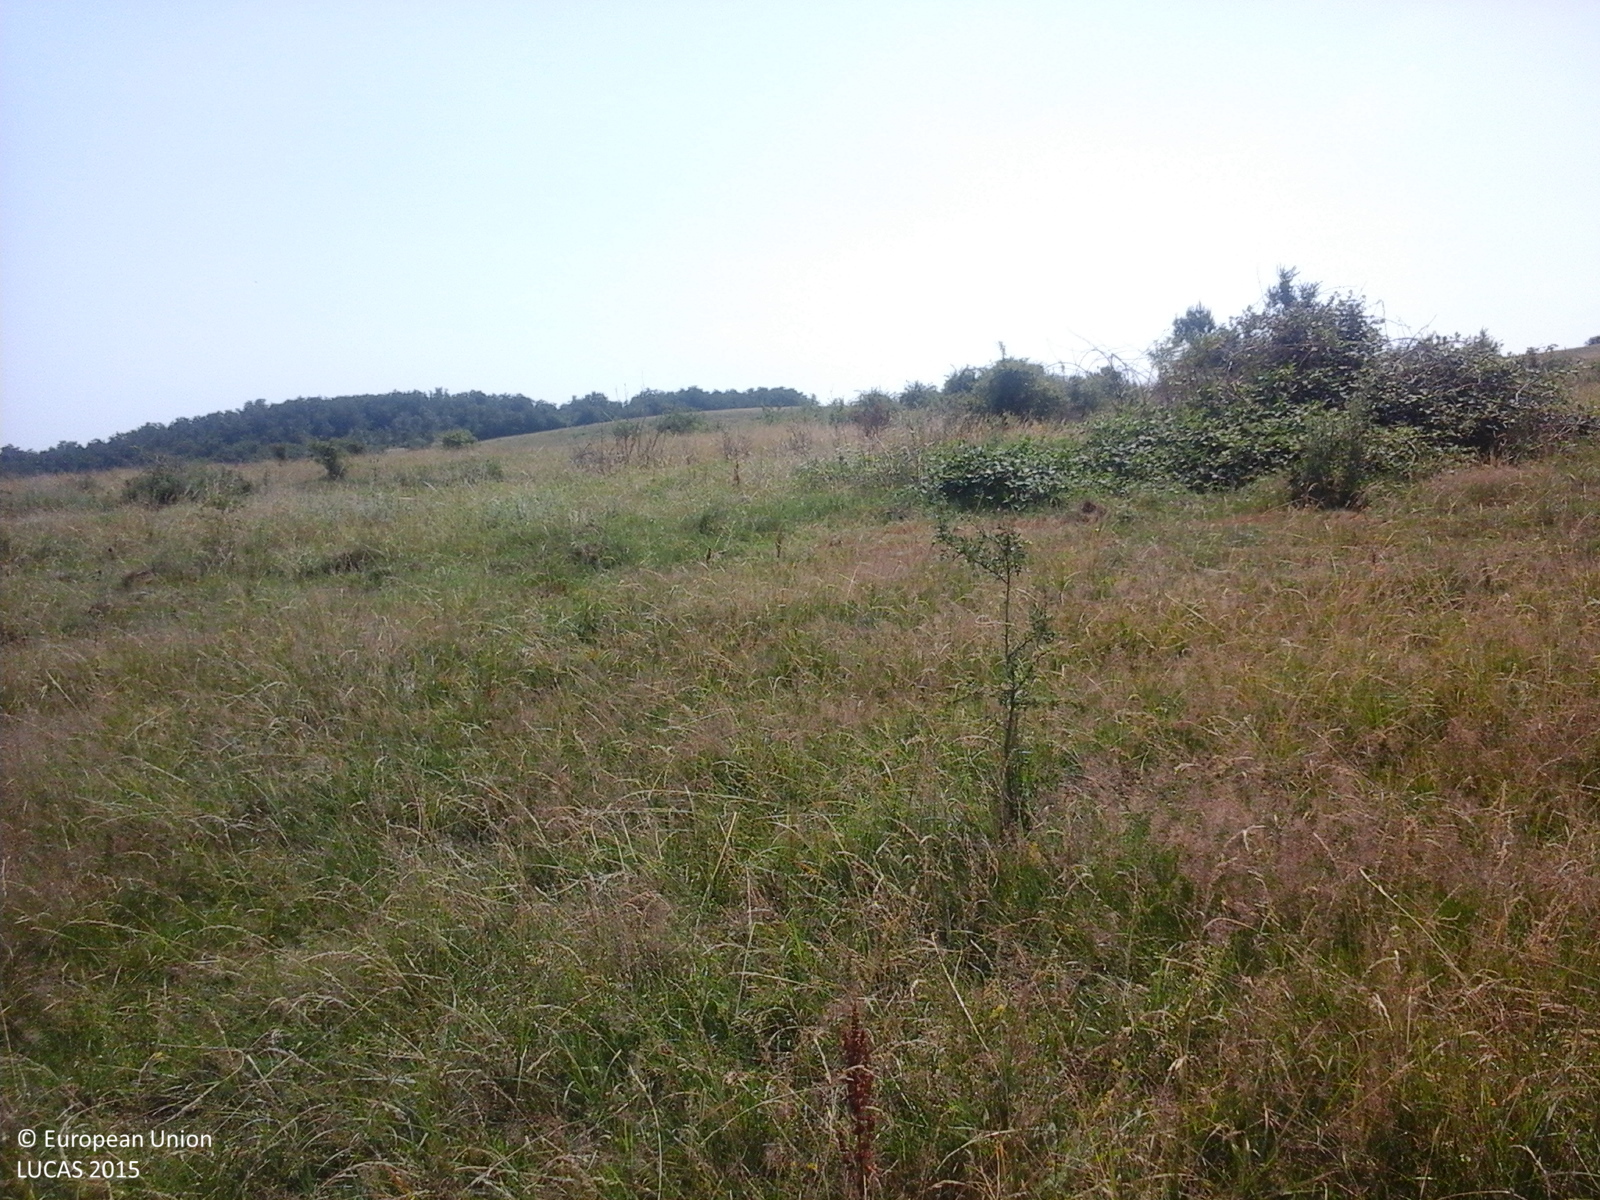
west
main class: Grassland
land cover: Grassland without tree/shrub cover
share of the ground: > 75 %
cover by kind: herbaceous plants 100 %
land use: Agriculture (excluding fallow land and kitchen gardens)
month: July
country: RO
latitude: 45.2130
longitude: 24.9978
